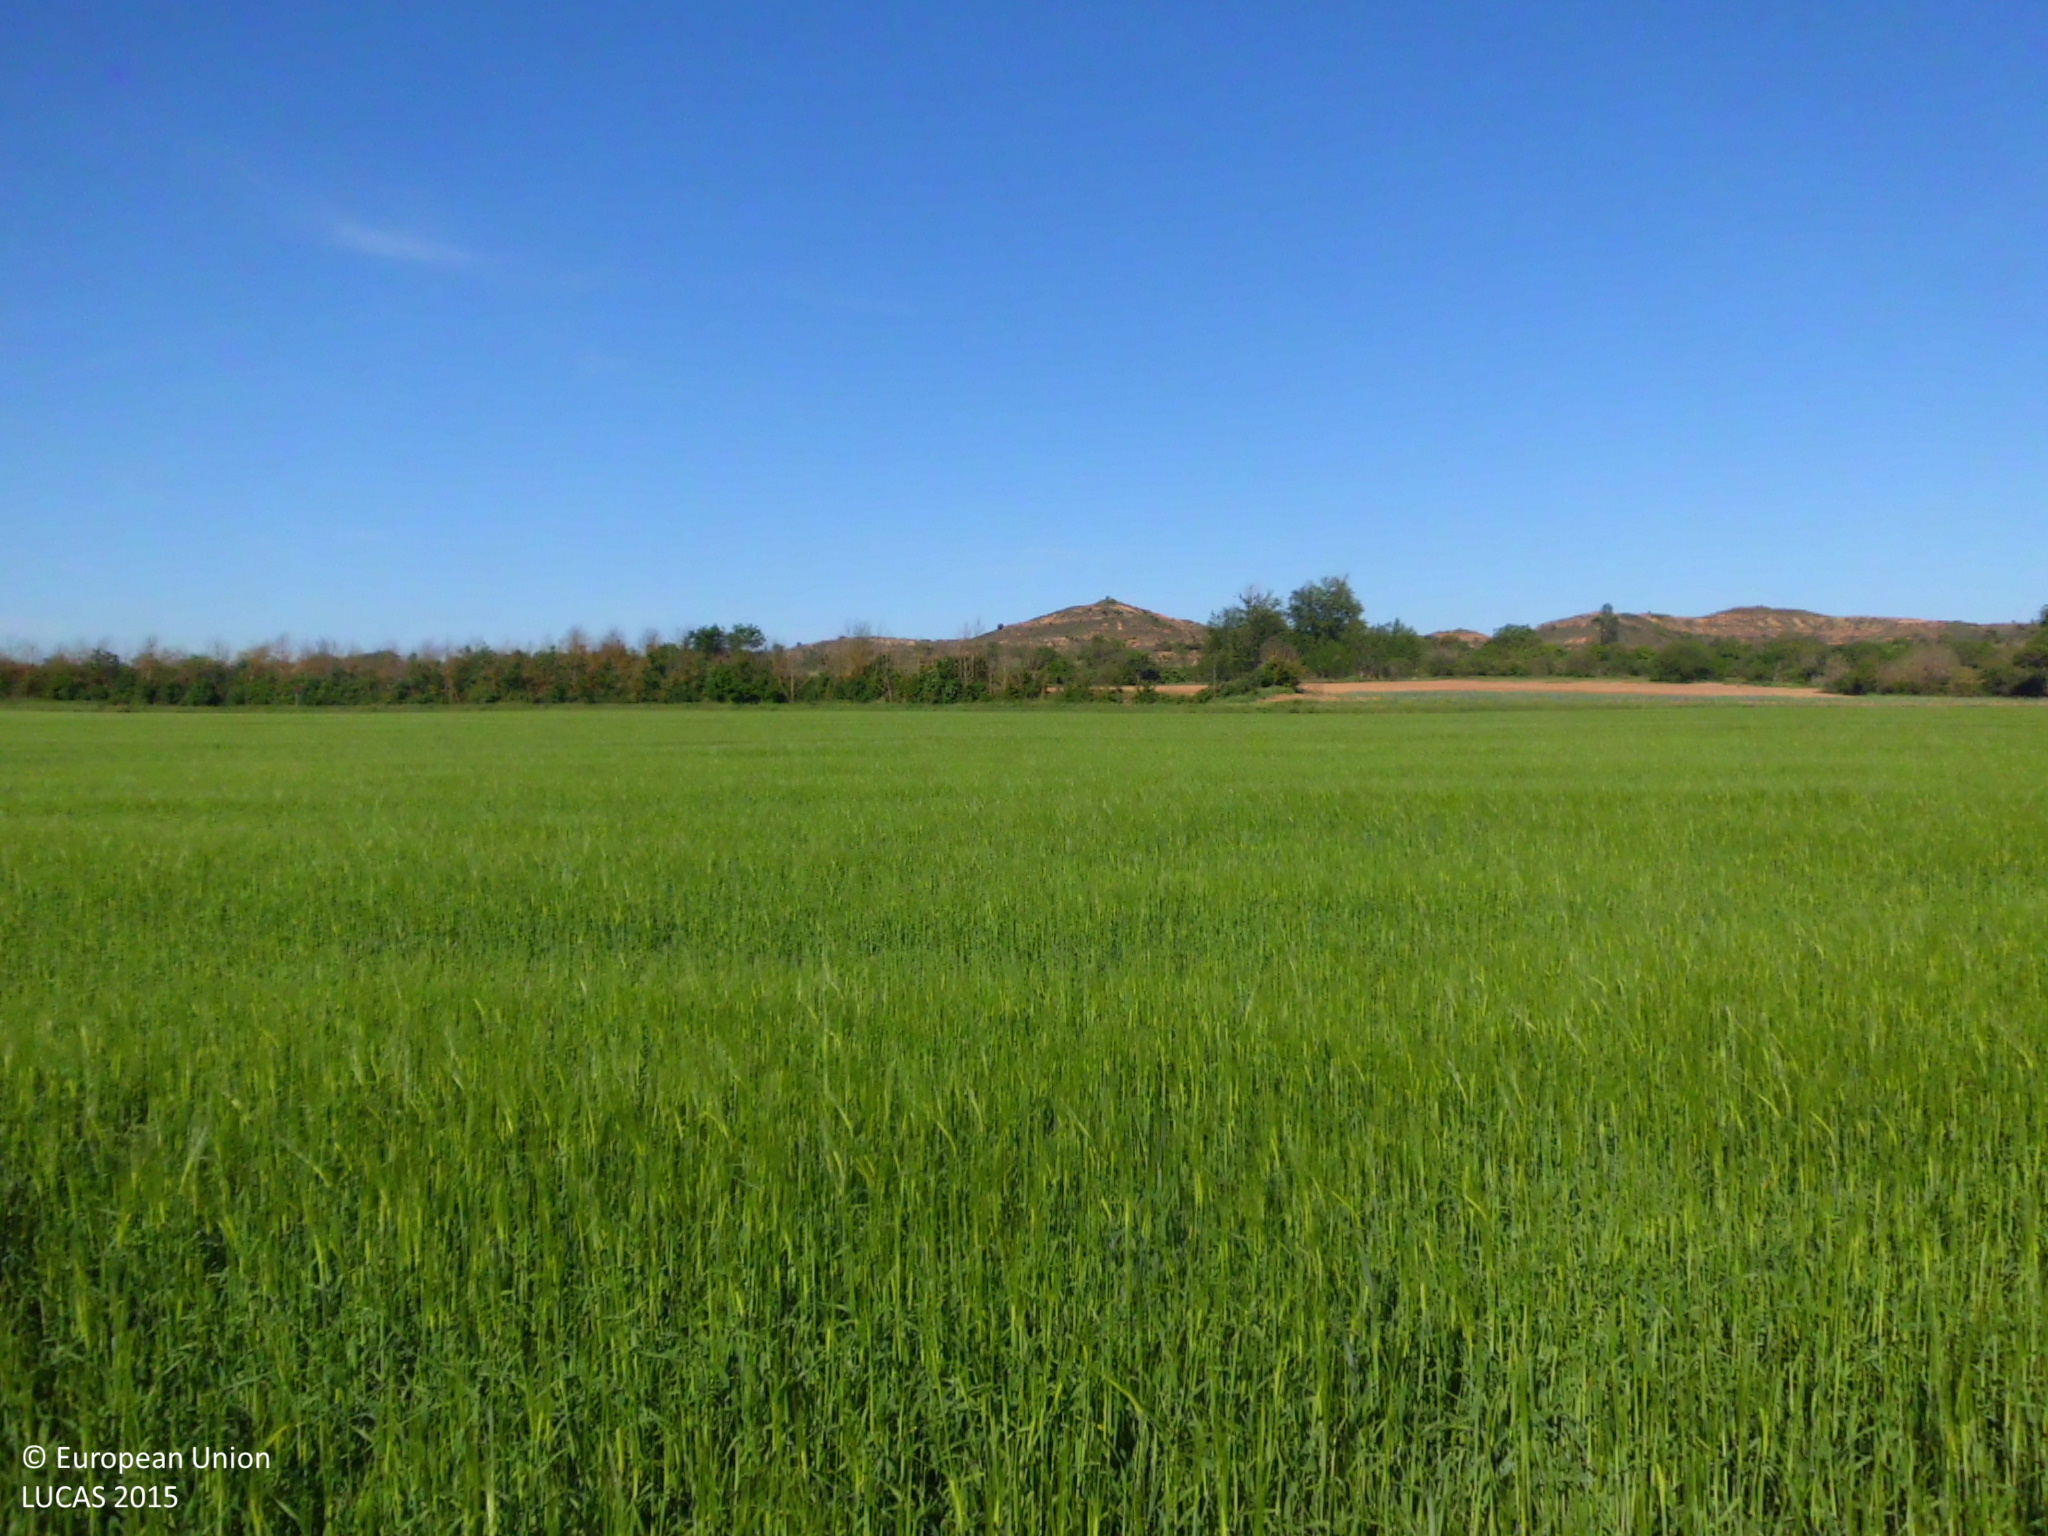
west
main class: Cropland
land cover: Barley
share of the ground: > 75 %
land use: Agriculture (excluding fallow land and kitchen gardens)
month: May
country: ES
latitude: 42.6284
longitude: -3.4607
